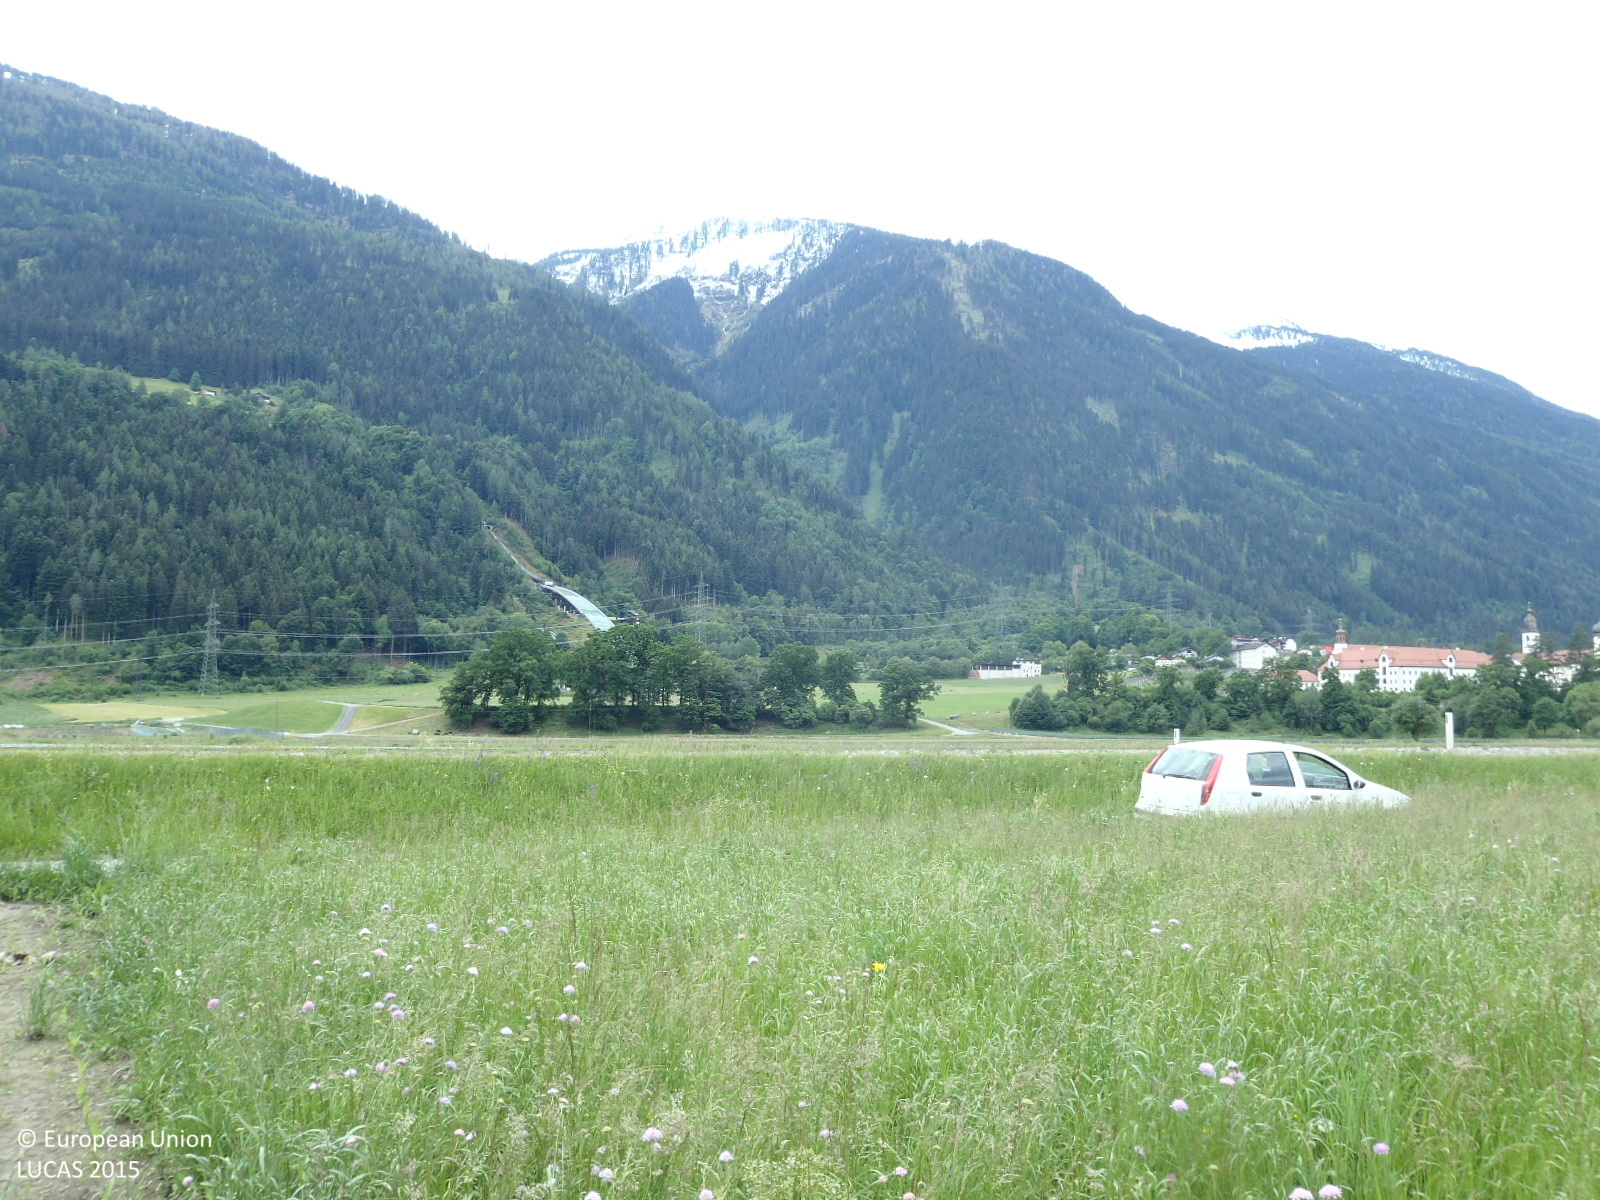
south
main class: Cropland
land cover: Maize
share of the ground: < 10 %
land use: Agriculture (excluding fallow land and kitchen gardens)
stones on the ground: < 10 %
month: May
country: AT
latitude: 47.2831
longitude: 10.9907
